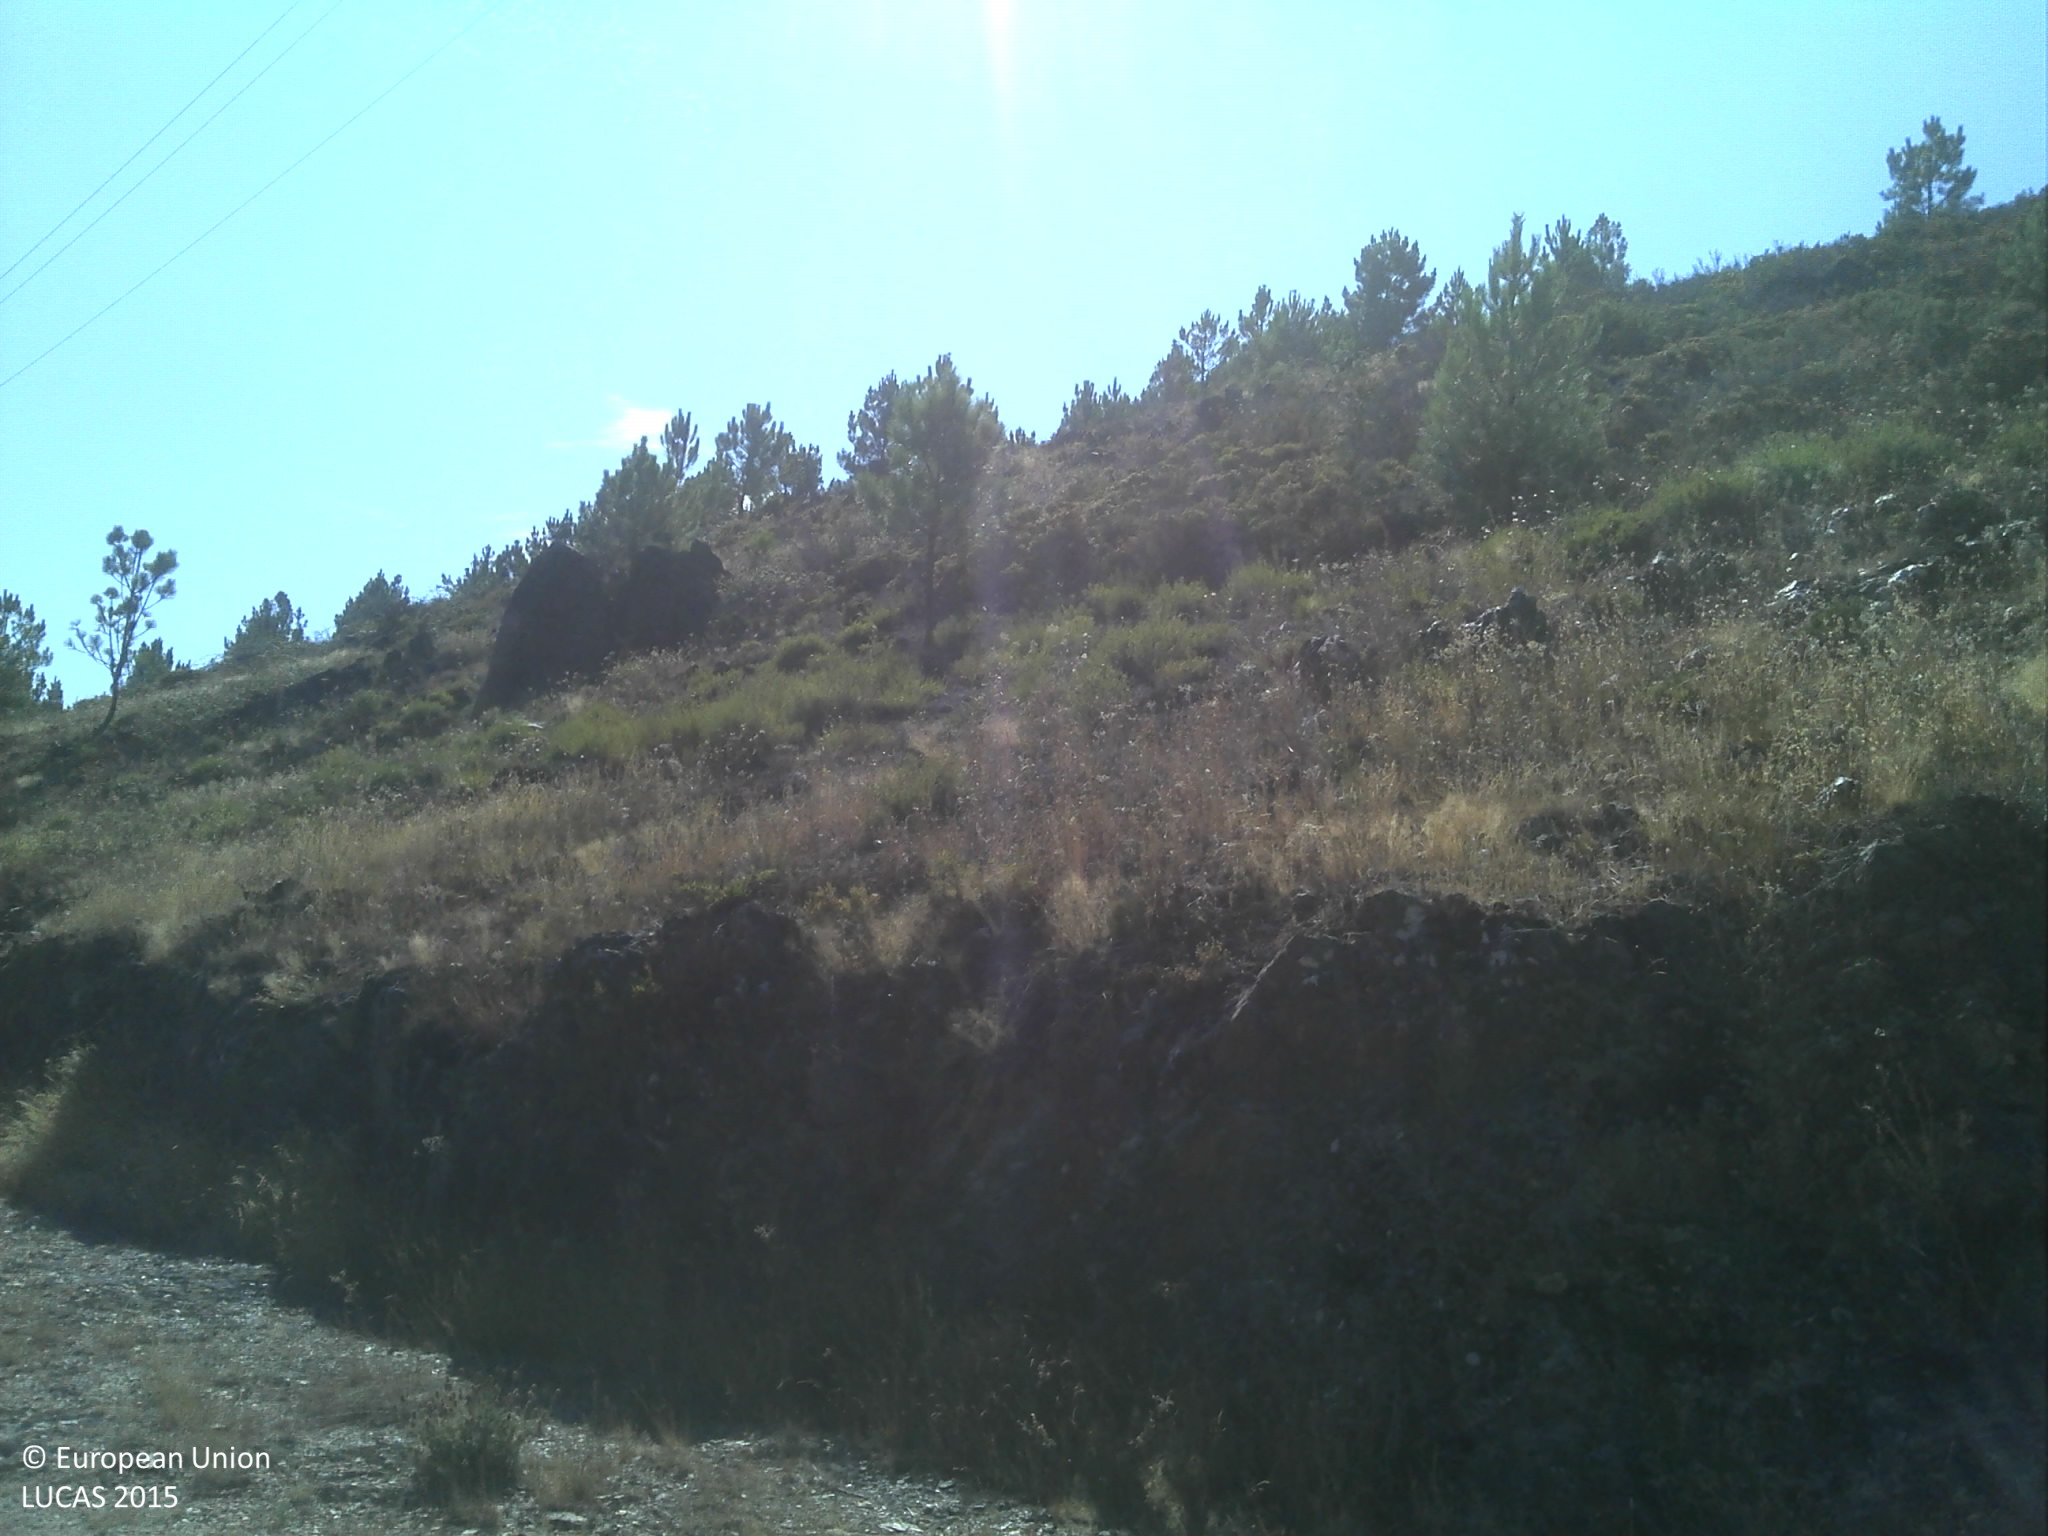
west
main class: Shrubland
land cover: Shrubland without tree cover
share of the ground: > 75 %
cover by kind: shrubs 75 %, unconsolidated bare surface 25 %
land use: Semi-natural and natural areas not in use
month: July
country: PT
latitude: 40.3049
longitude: -7.7026
